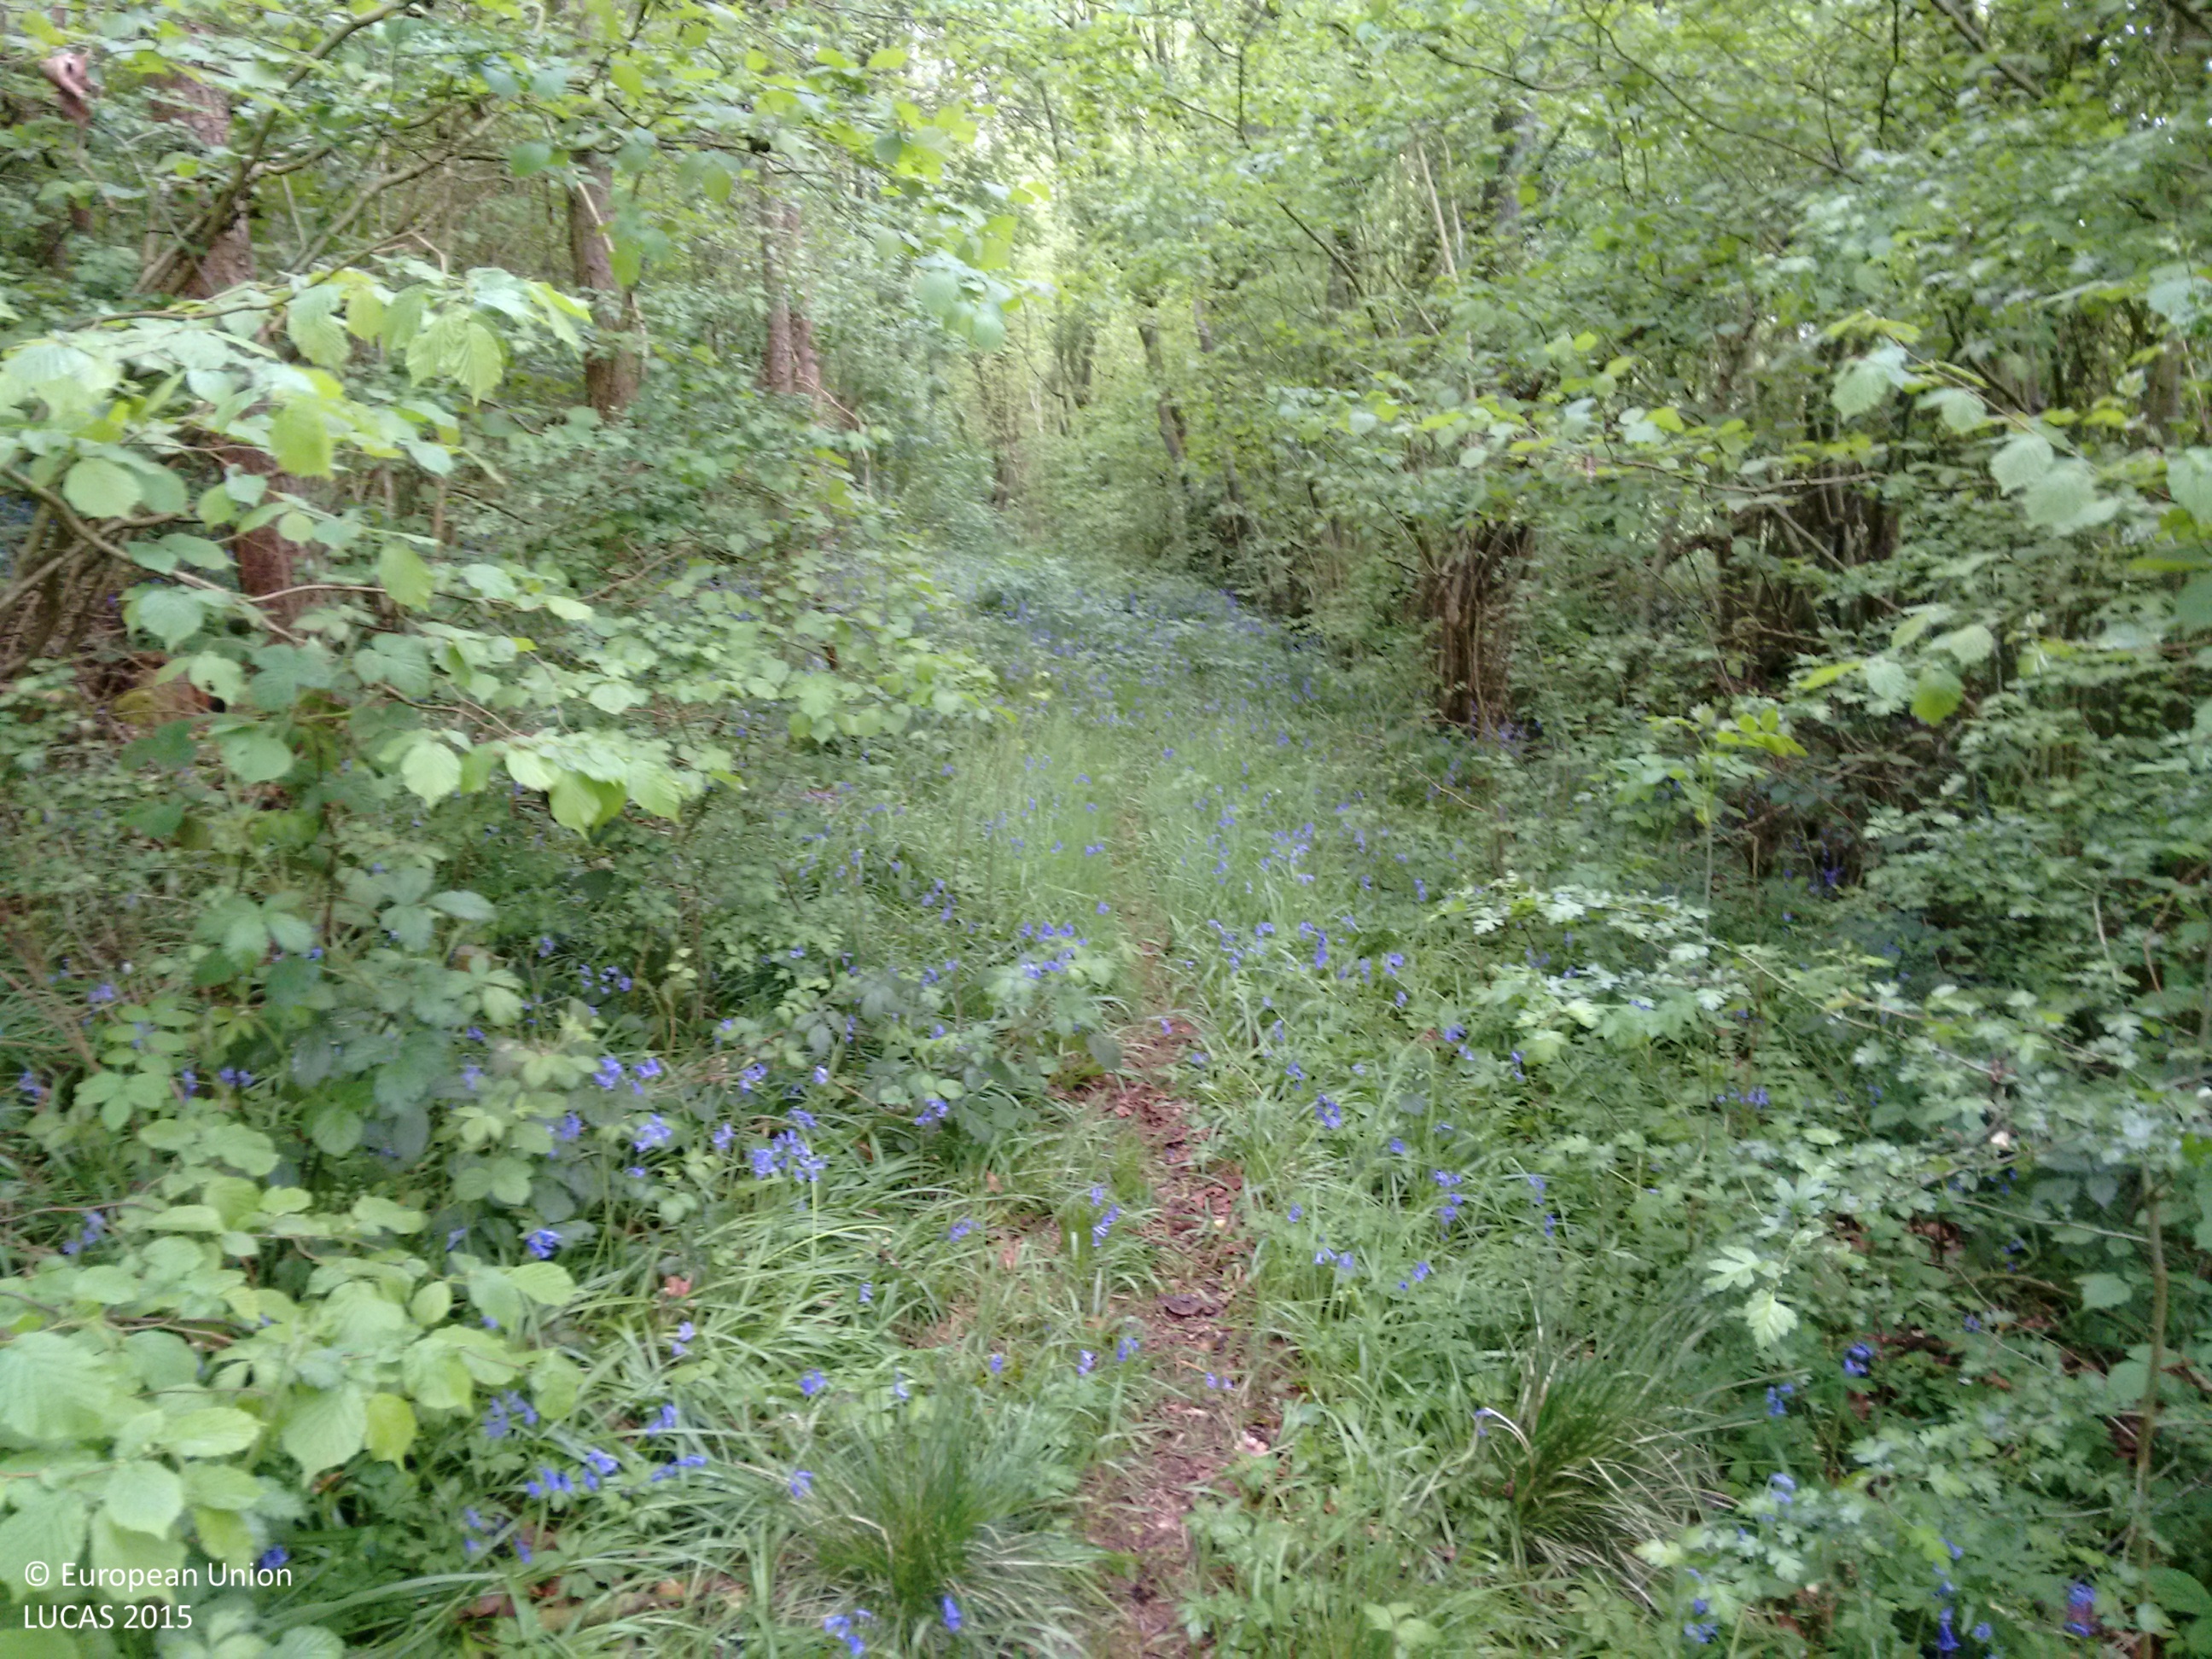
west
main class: Woodland
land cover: Broadleaved woodland
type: mesophytic deciduous forest
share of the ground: > 75 %
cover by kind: broadleaved forest trees 85 %, herbaceous plants 10 %, shrubs 5 %
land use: Semi-natural and natural areas not in use
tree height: > 5 m
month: May
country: GB
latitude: 52.2924
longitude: -2.1865
